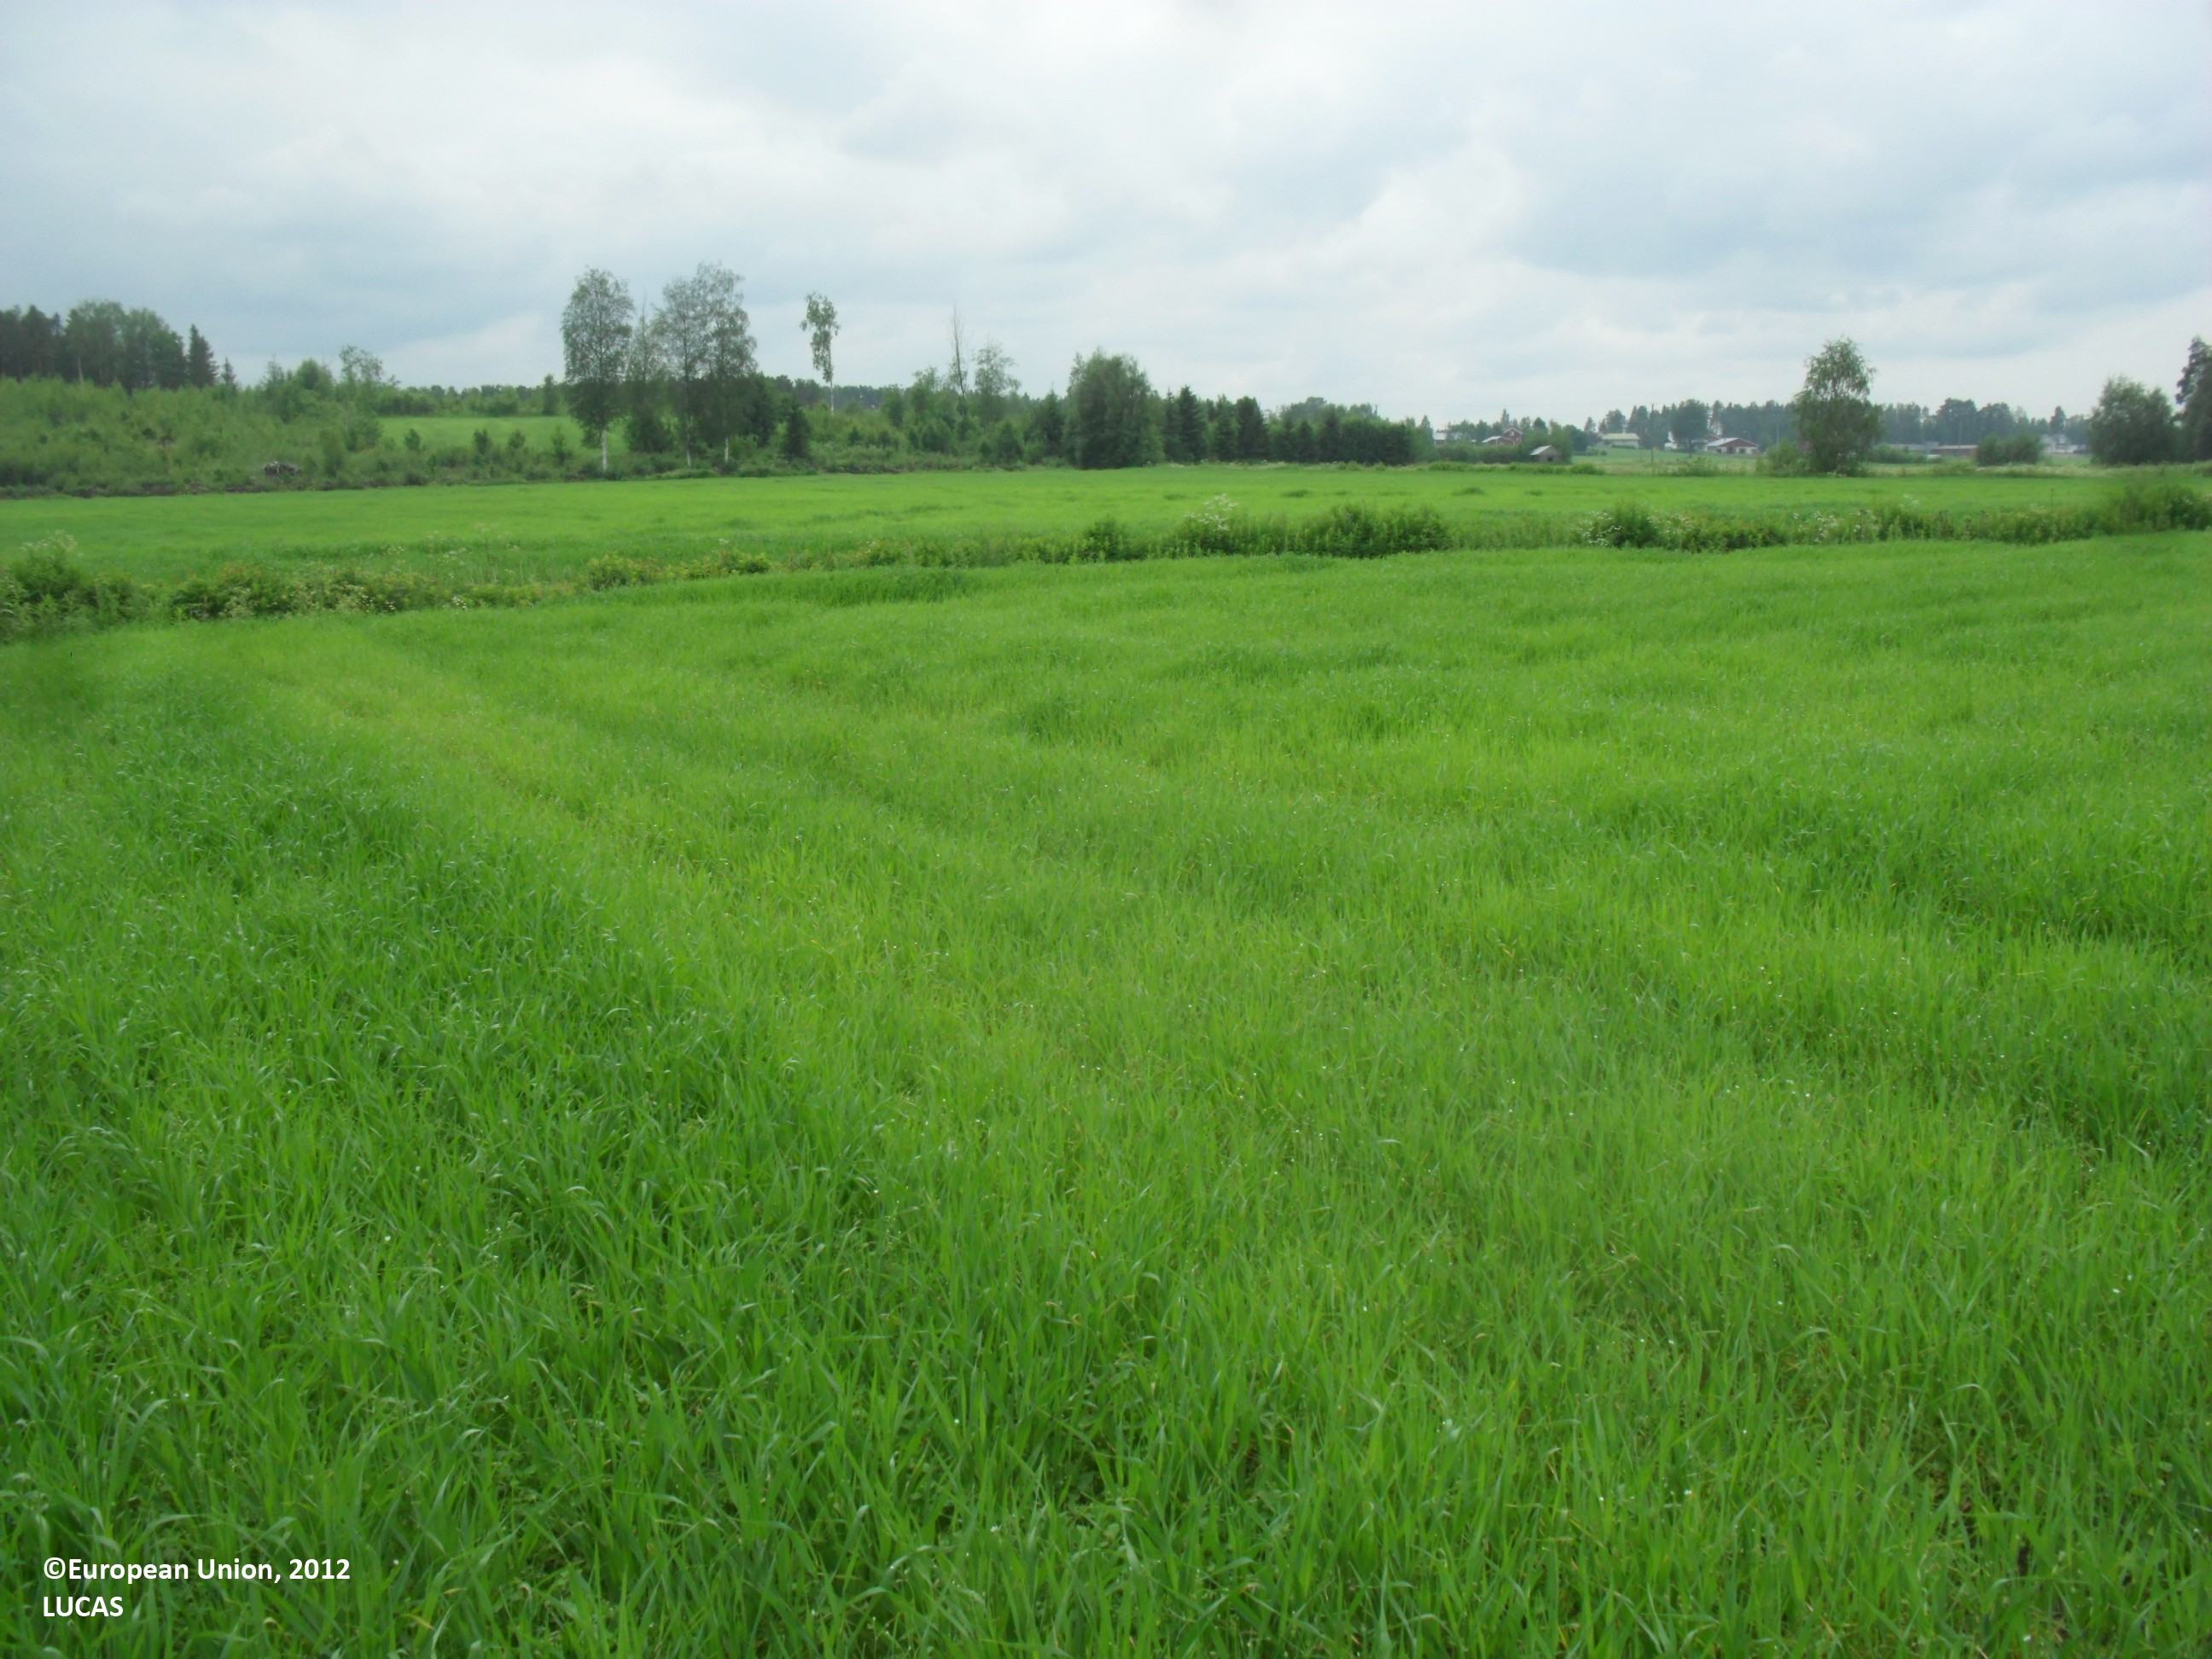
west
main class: Cropland
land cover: Barley
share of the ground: > 75 %
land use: Agriculture (excluding fallow land and kitchen gardens)
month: July
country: FI
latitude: 63.5971
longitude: 23.5053
